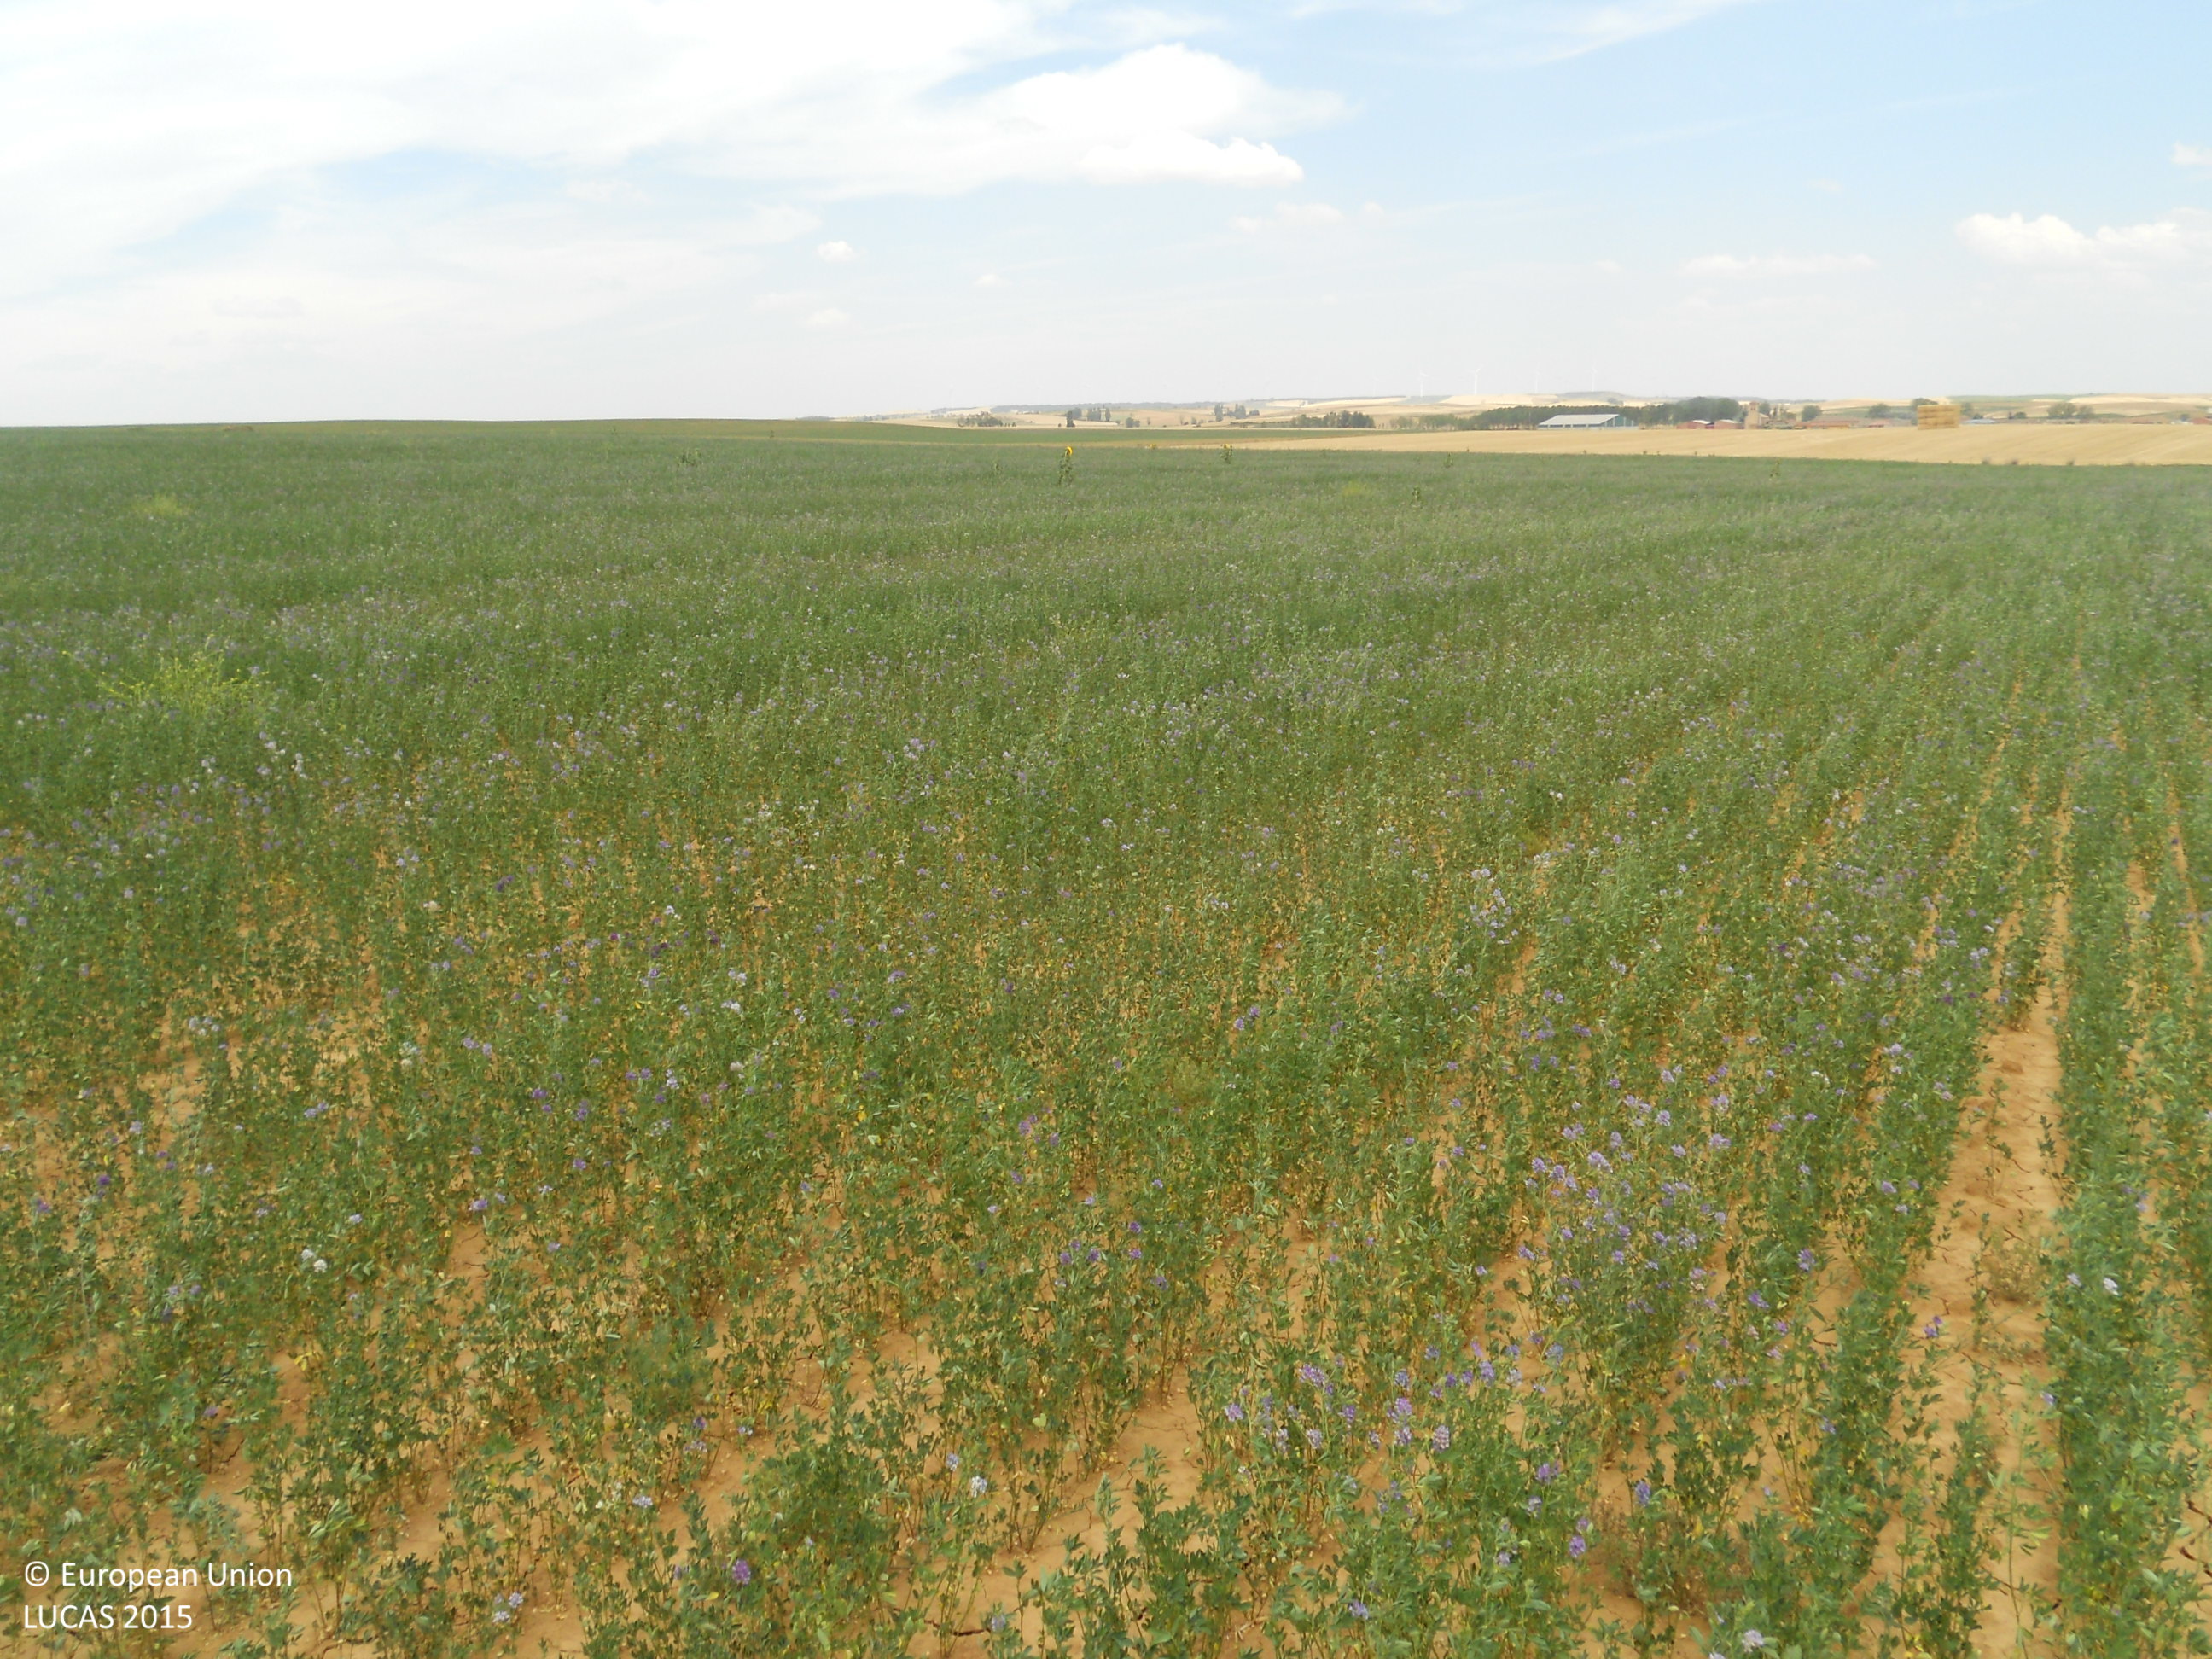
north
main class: Cropland
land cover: Lucerne
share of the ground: > 75 %
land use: Agriculture (excluding fallow land and kitchen gardens)
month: July
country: ES
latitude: 42.2025
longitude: -4.7923
